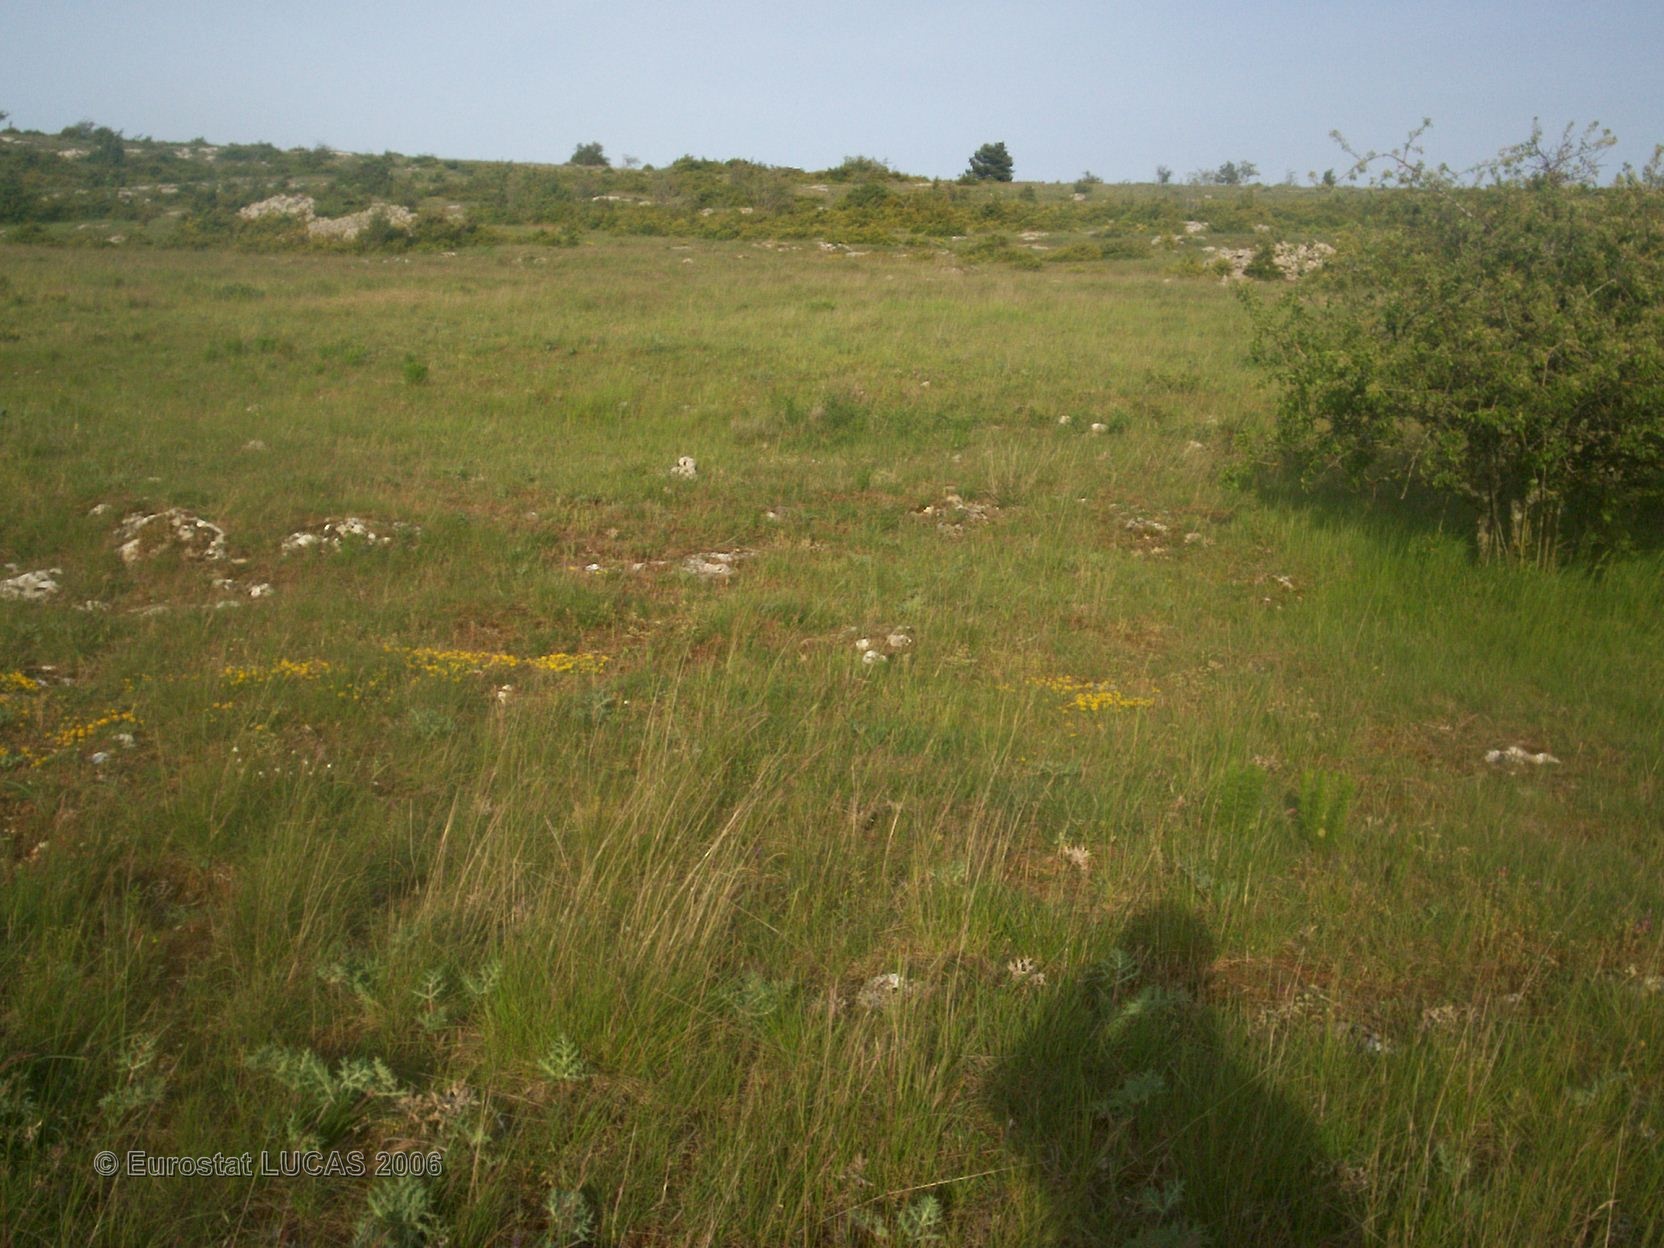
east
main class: Grassland
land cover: Grassland with sparse tree/shrub cover
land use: Agriculture (excluding fallow land and kitchen gardens)
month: June
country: FR
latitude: 44.3782
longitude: 3.4415
